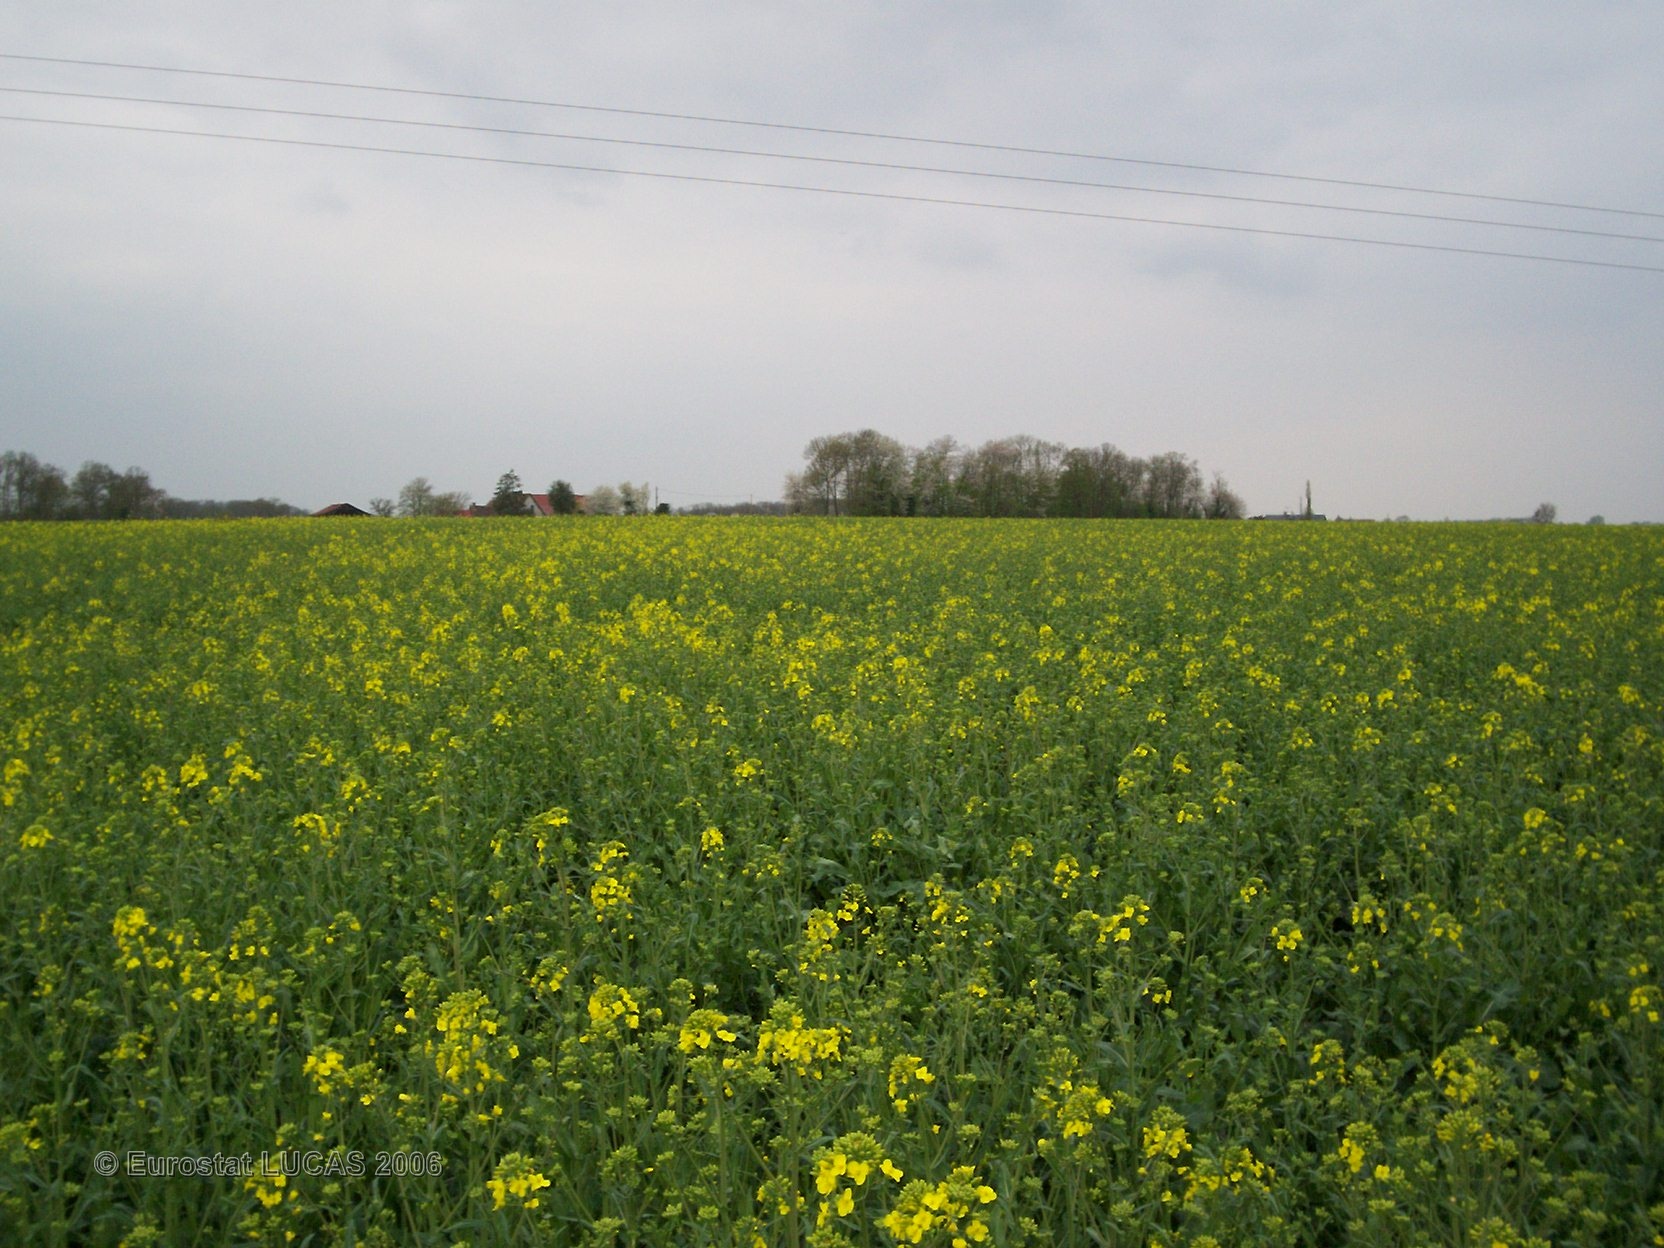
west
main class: Cropland
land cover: Rape and turnip rape
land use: Agriculture (excluding fallow land and kitchen gardens)
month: April
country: FR
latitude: 48.8725
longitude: 1.0487
